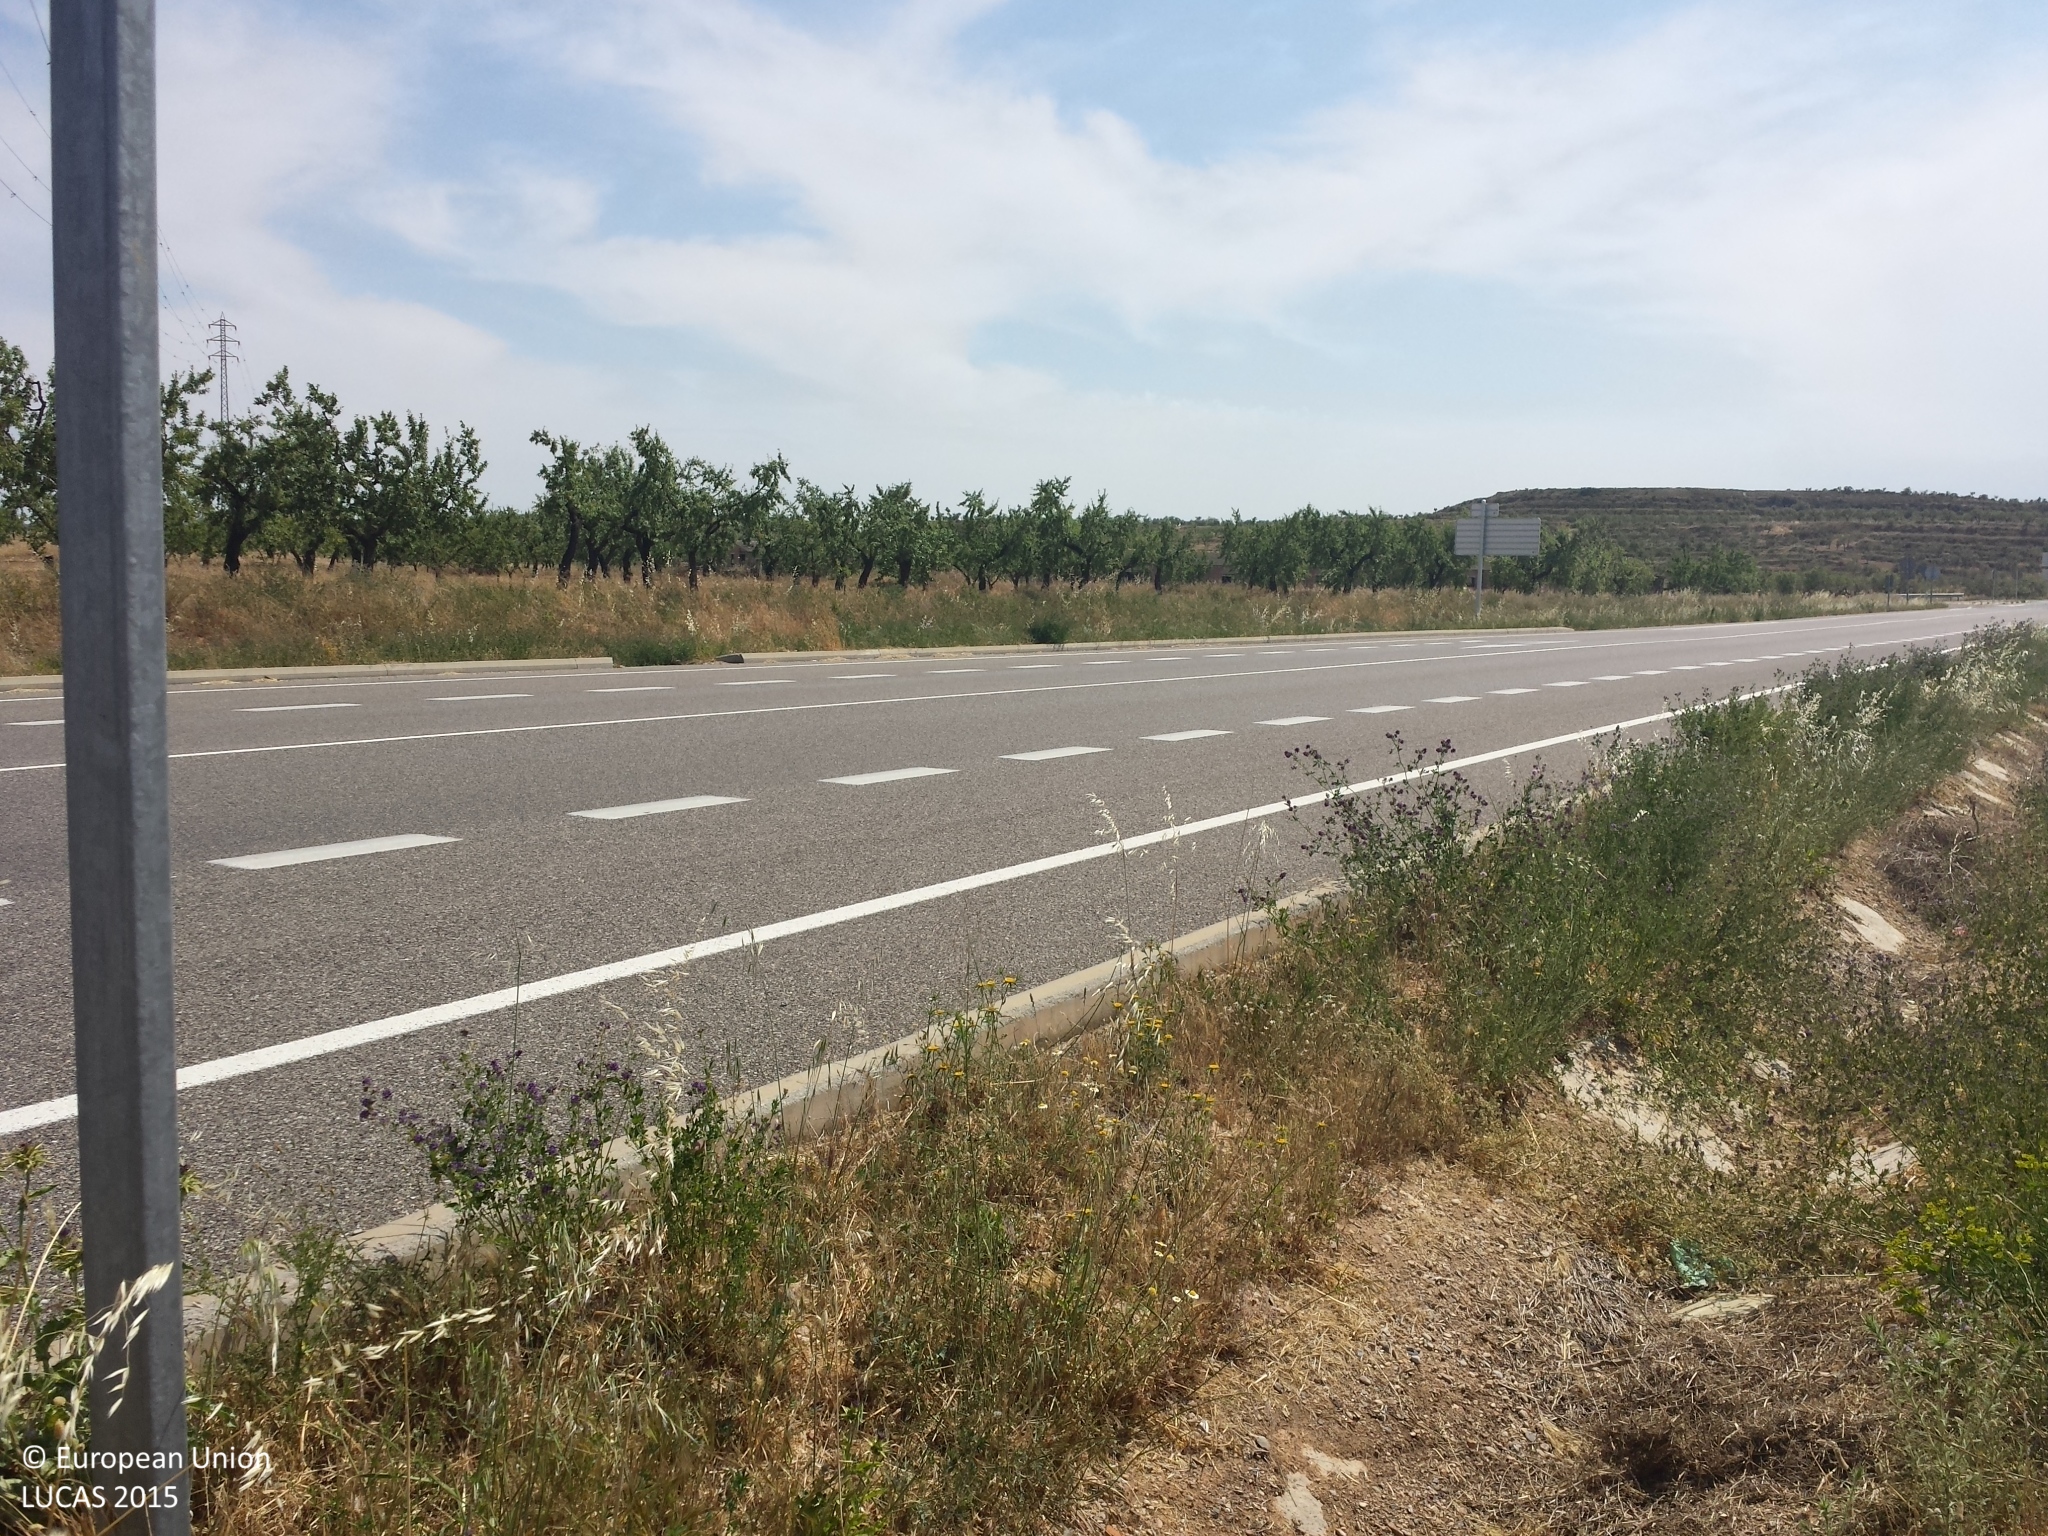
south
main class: Grassland
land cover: Grassland without tree/shrub cover
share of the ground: 50 - 75 %
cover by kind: herbaceous plants 60 %, unconsolidated bare surface 30 %, shrubs 5 %, consolidated bare surface 5 %
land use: Road transport
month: May
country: ES
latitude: 41.4899
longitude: 0.6101
